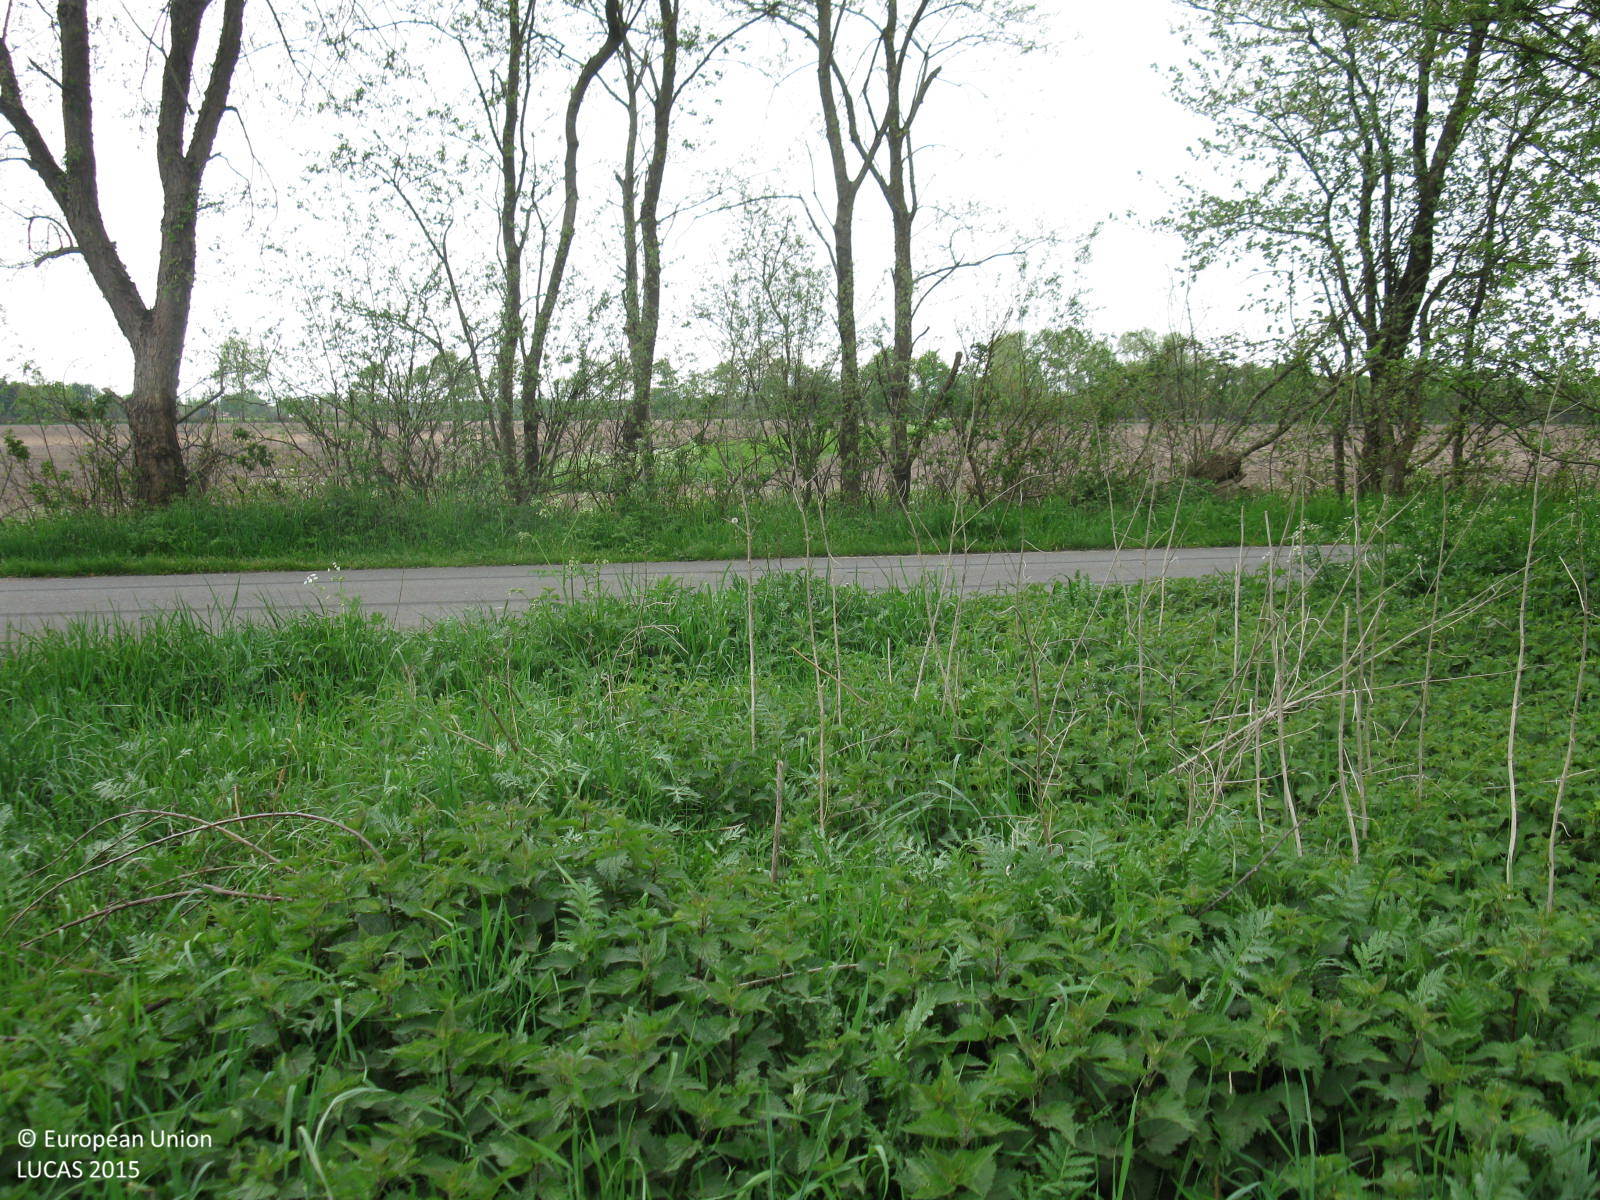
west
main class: Cropland
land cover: Triticale
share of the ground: > 75 %
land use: Agriculture (excluding fallow land and kitchen gardens)
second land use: Community services
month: May
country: DE
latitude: 52.8706
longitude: 7.4006
